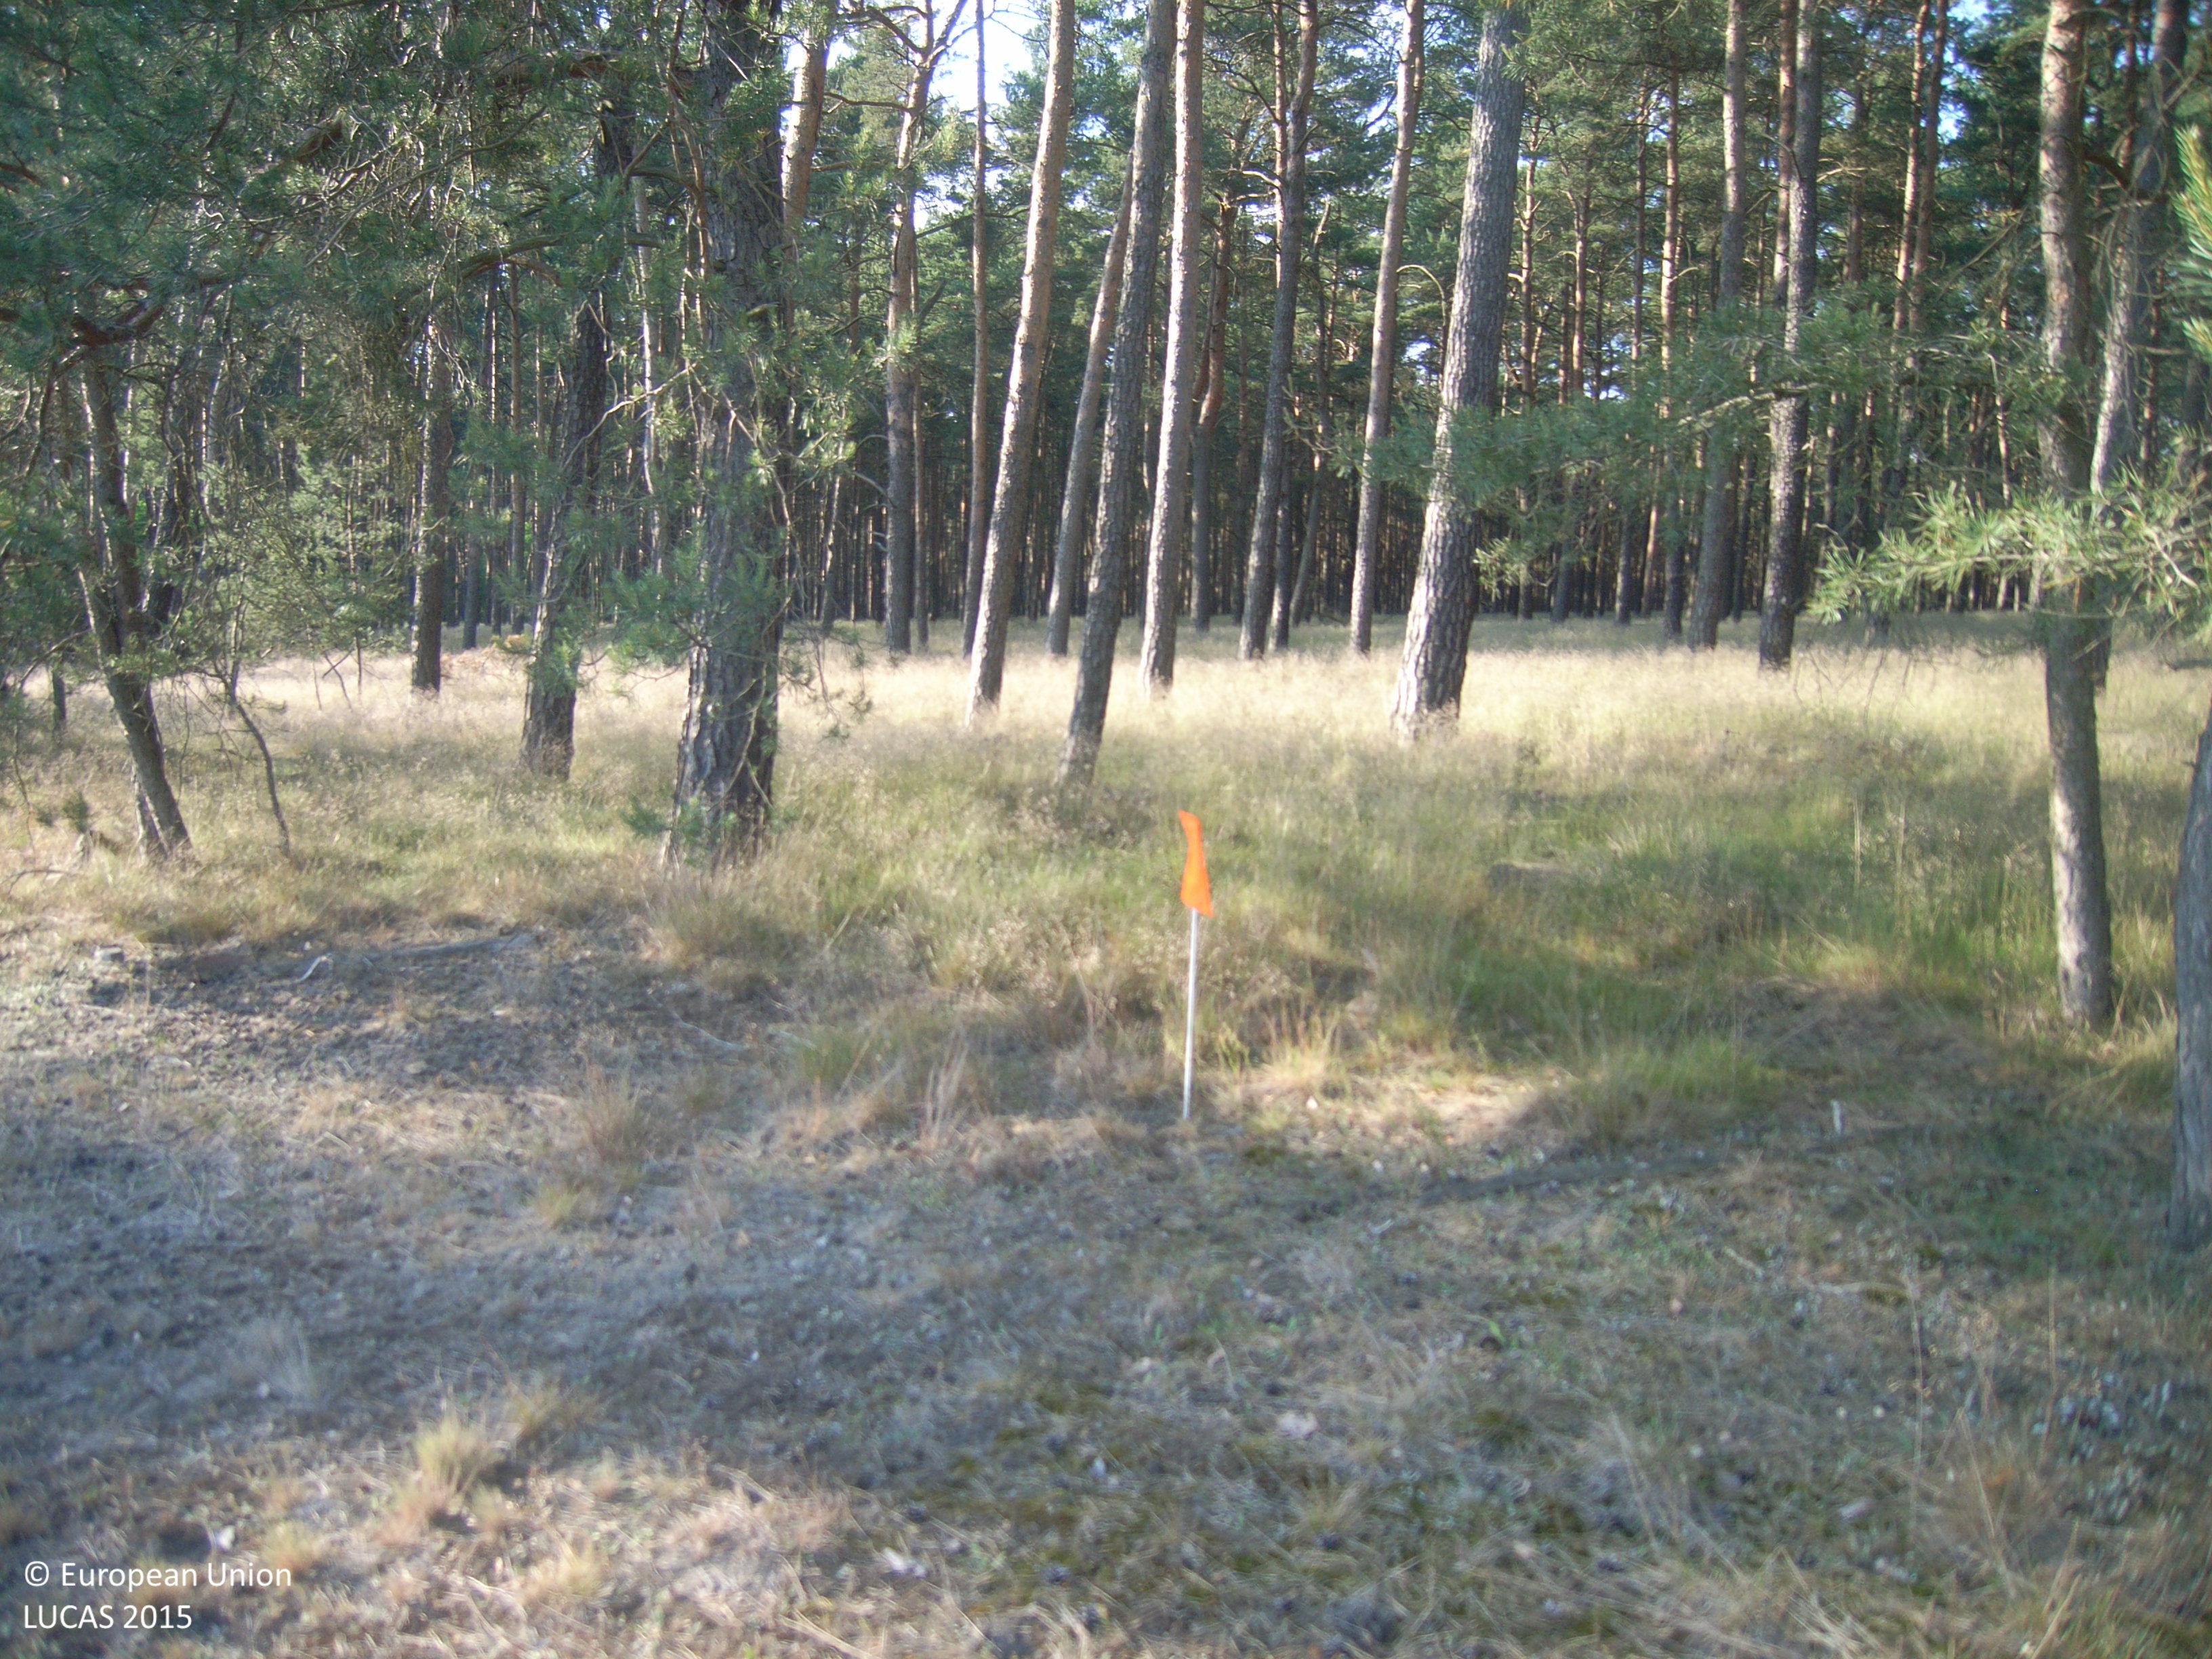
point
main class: Woodland
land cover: Pine dominated coniferous woodland
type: hemiboreal forest and nemoral coniferous forest and mixed broadleaved-coniferous forest
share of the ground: > 75 %
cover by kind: coniferous forest trees 100 %
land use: Forestry
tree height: > 5 m
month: June
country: DE
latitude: 52.0368
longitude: 14.0974
